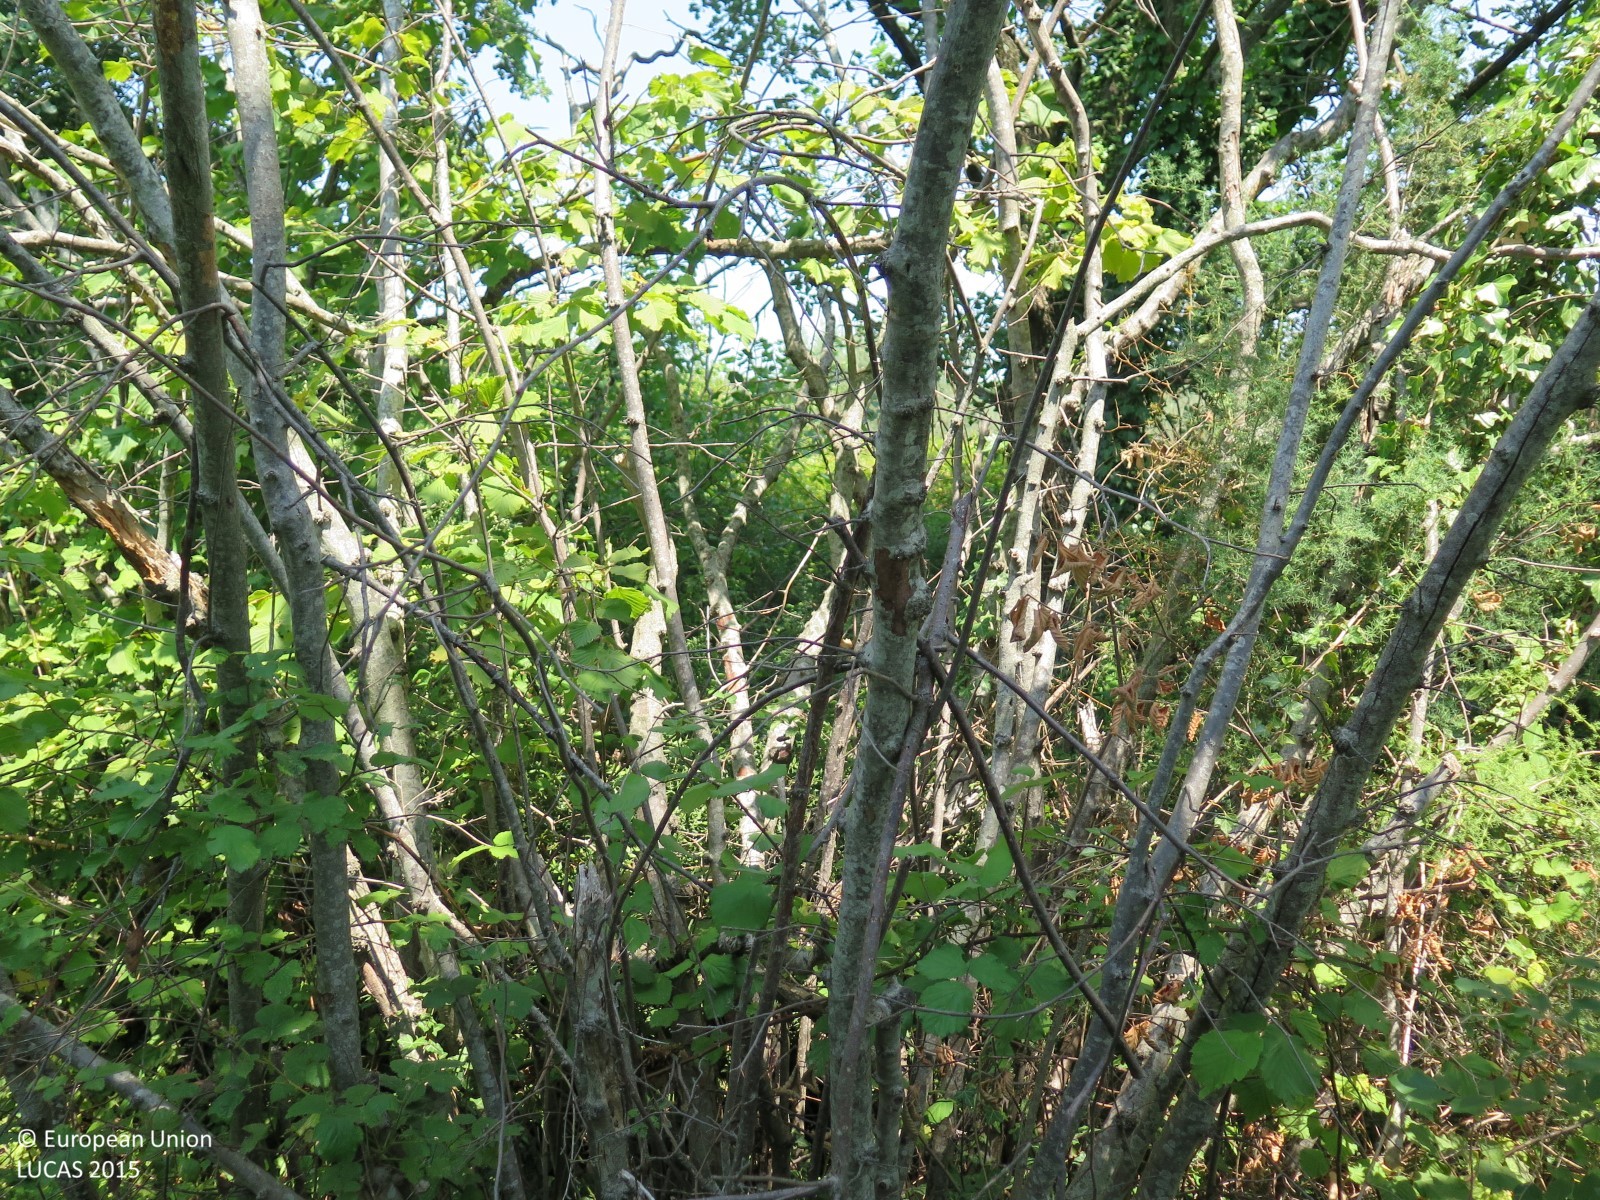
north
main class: Woodland
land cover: Broadleaved woodland
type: mesophytic deciduous forest
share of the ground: 50 - 75 %
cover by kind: broadleaved forest trees 90 %, shrubs 5 %, herbaceous plants 5 %
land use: Semi-natural and natural areas not in use
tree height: > 5 m
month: July
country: HR
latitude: 45.3517
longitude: 13.6329
